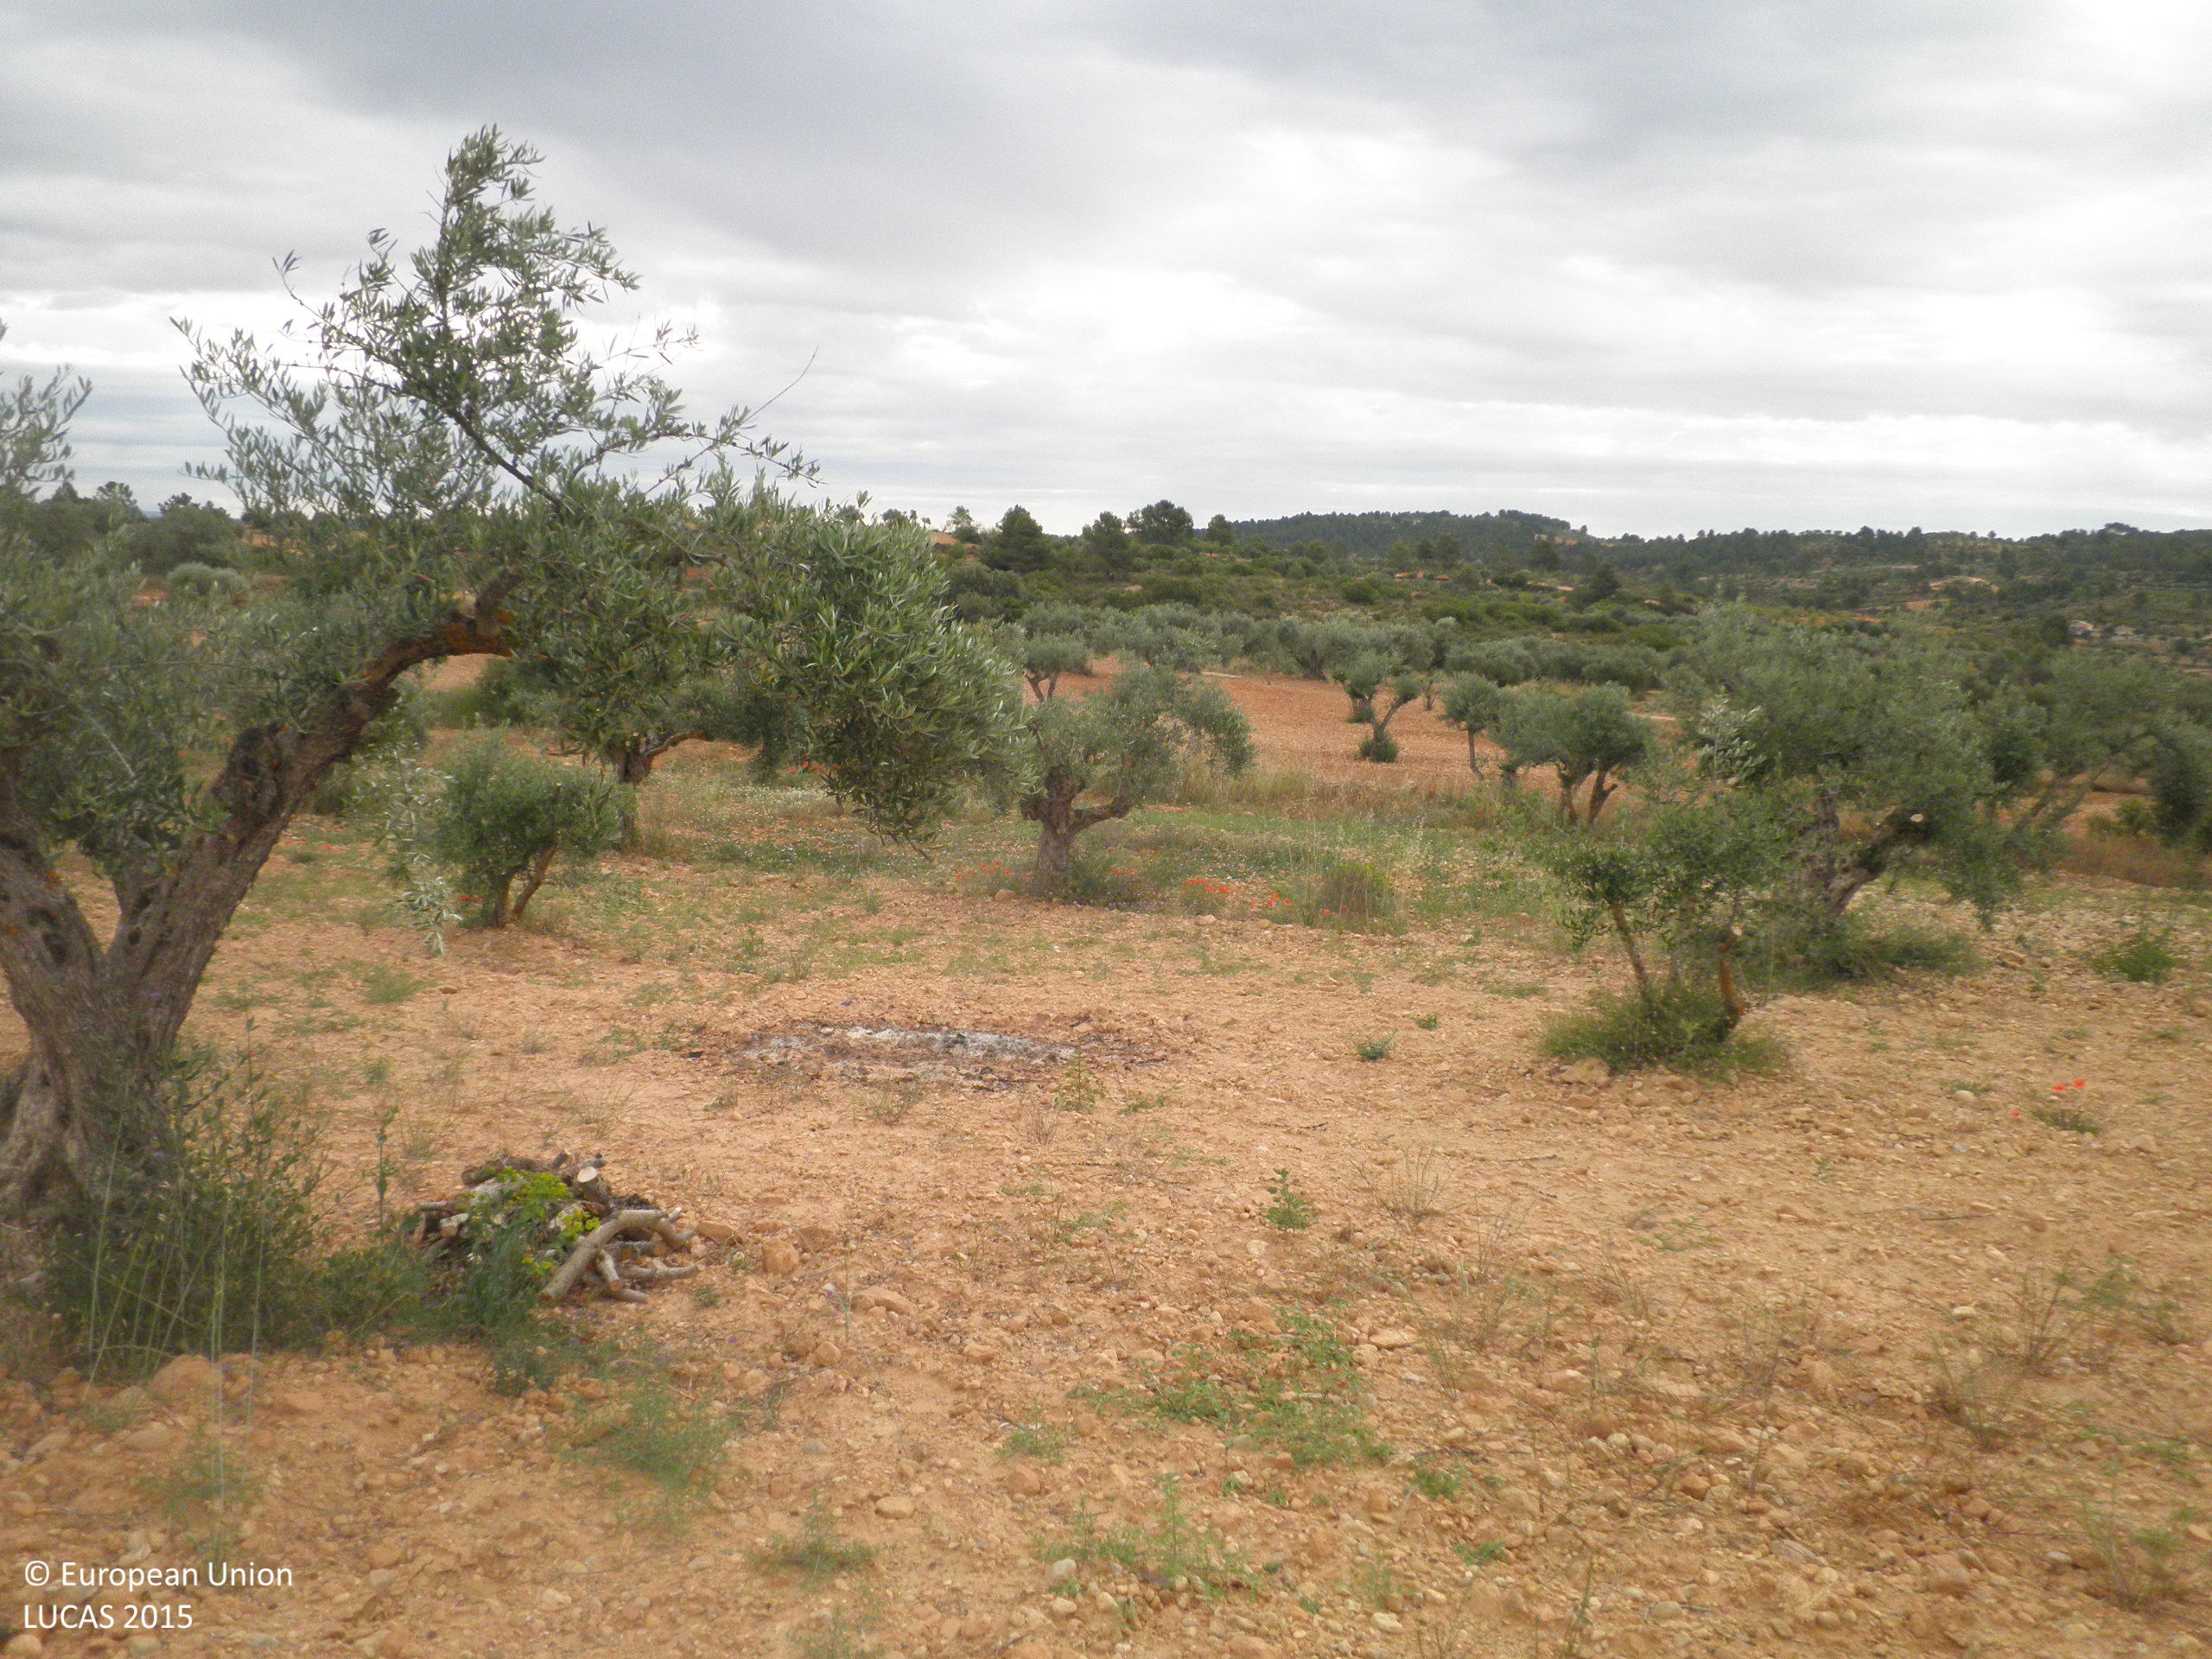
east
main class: Cropland
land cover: Olive groves
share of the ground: < 10 %
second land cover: Spontaneously vegetated surfaces
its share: > 75 %
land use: Agriculture (excluding fallow land and kitchen gardens)
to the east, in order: Olive groves; Spontaneously vegetated surfaces; Dry stone walls; Grass margins; Olive groves; Tracks; Olive groves; Tracks; Olive groves; Dry stone walls; Olive groves; Grass margins; Olive groves; Shrubland without tree cover
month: June
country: ES
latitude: 39.5781
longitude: -1.5893
